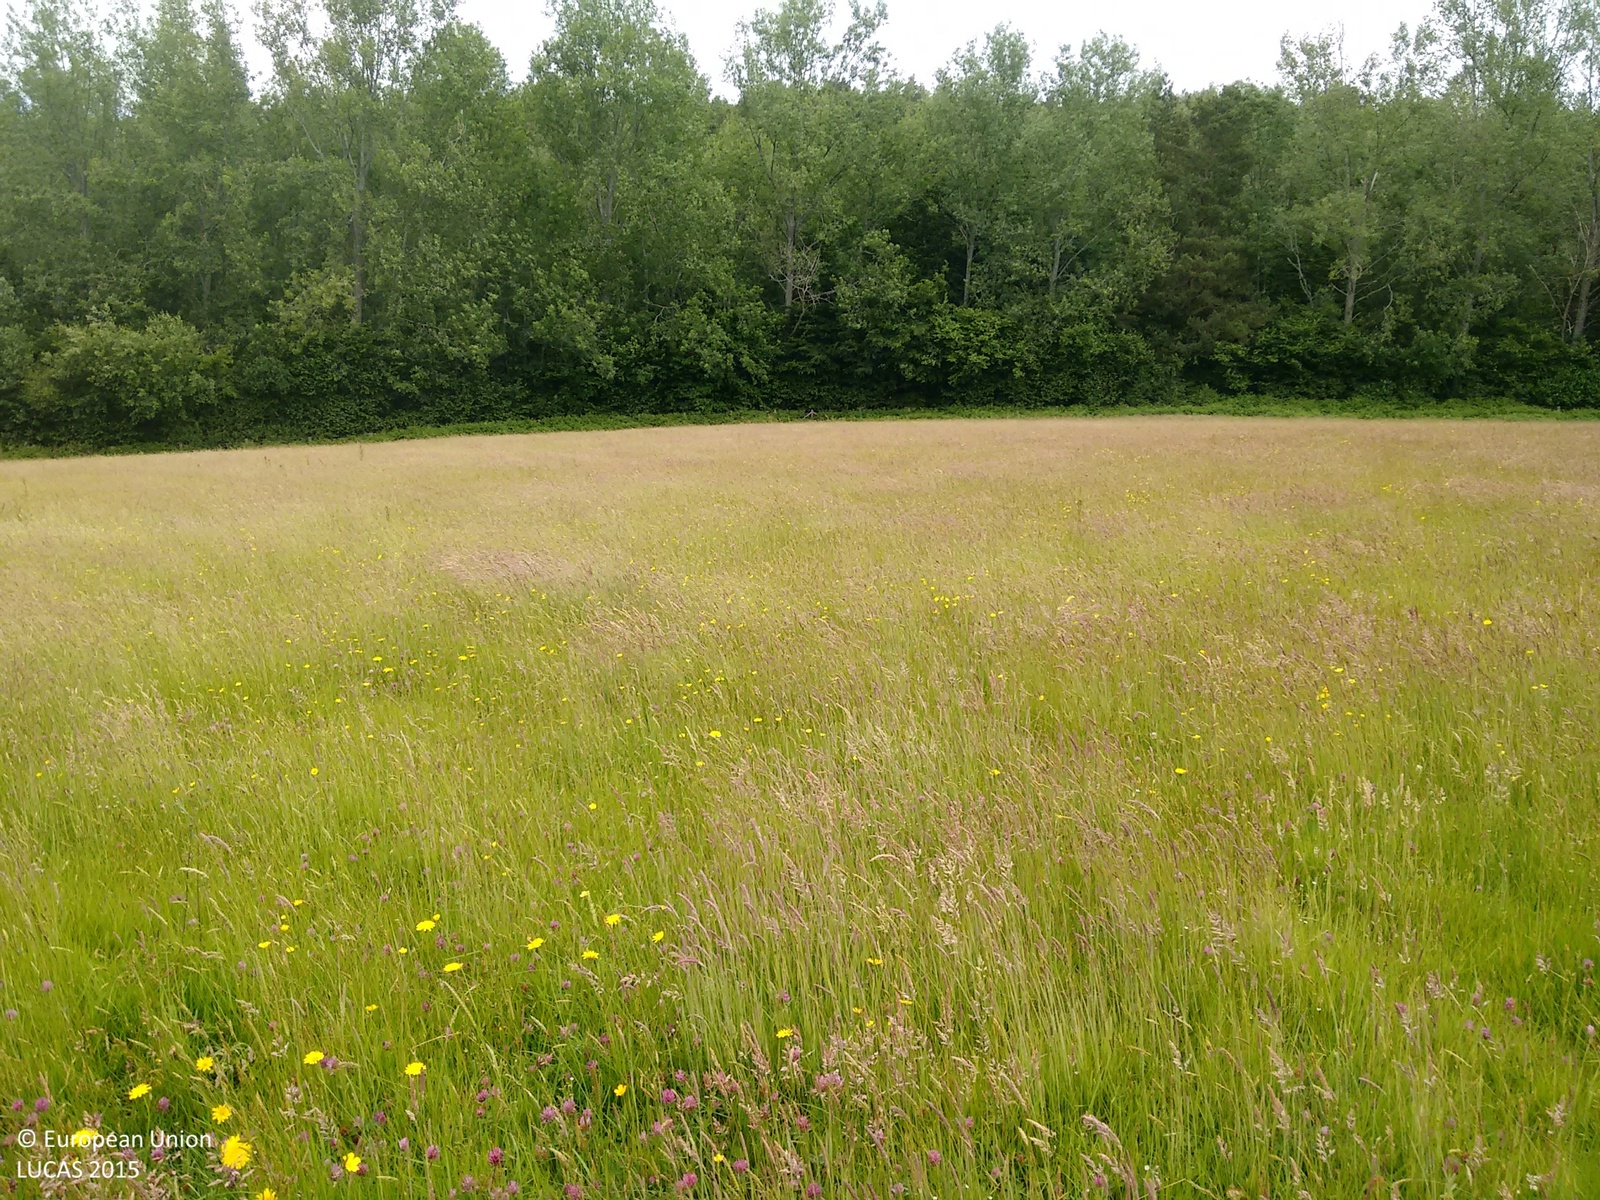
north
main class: Grassland
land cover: Grassland without tree/shrub cover
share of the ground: > 75 %
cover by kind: herbaceous plants 100 %
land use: Agriculture (excluding fallow land and kitchen gardens)
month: June
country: GB
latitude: 50.9214
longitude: 0.4261
